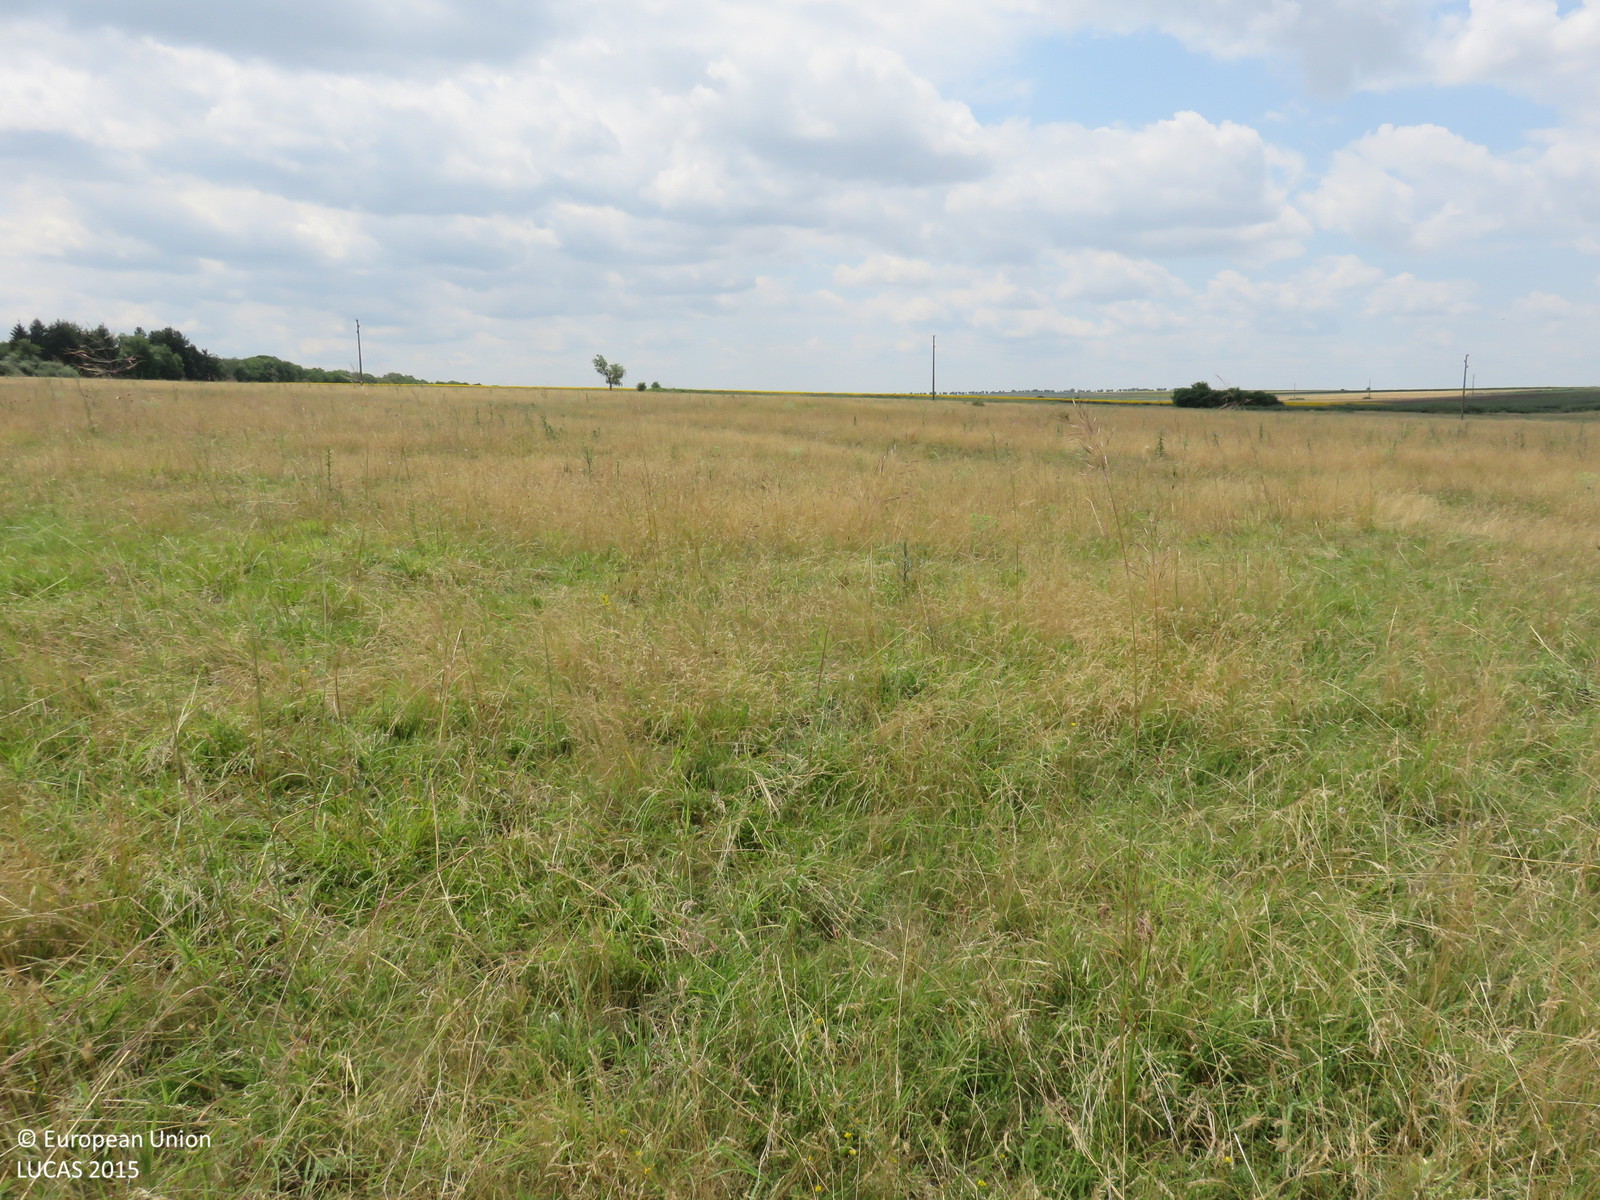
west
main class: Grassland
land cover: Grassland without tree/shrub cover
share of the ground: > 75 %
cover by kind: herbaceous plants 100 %
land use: Agriculture (excluding fallow land and kitchen gardens)
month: June
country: BG
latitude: 43.4318
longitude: 24.9053
